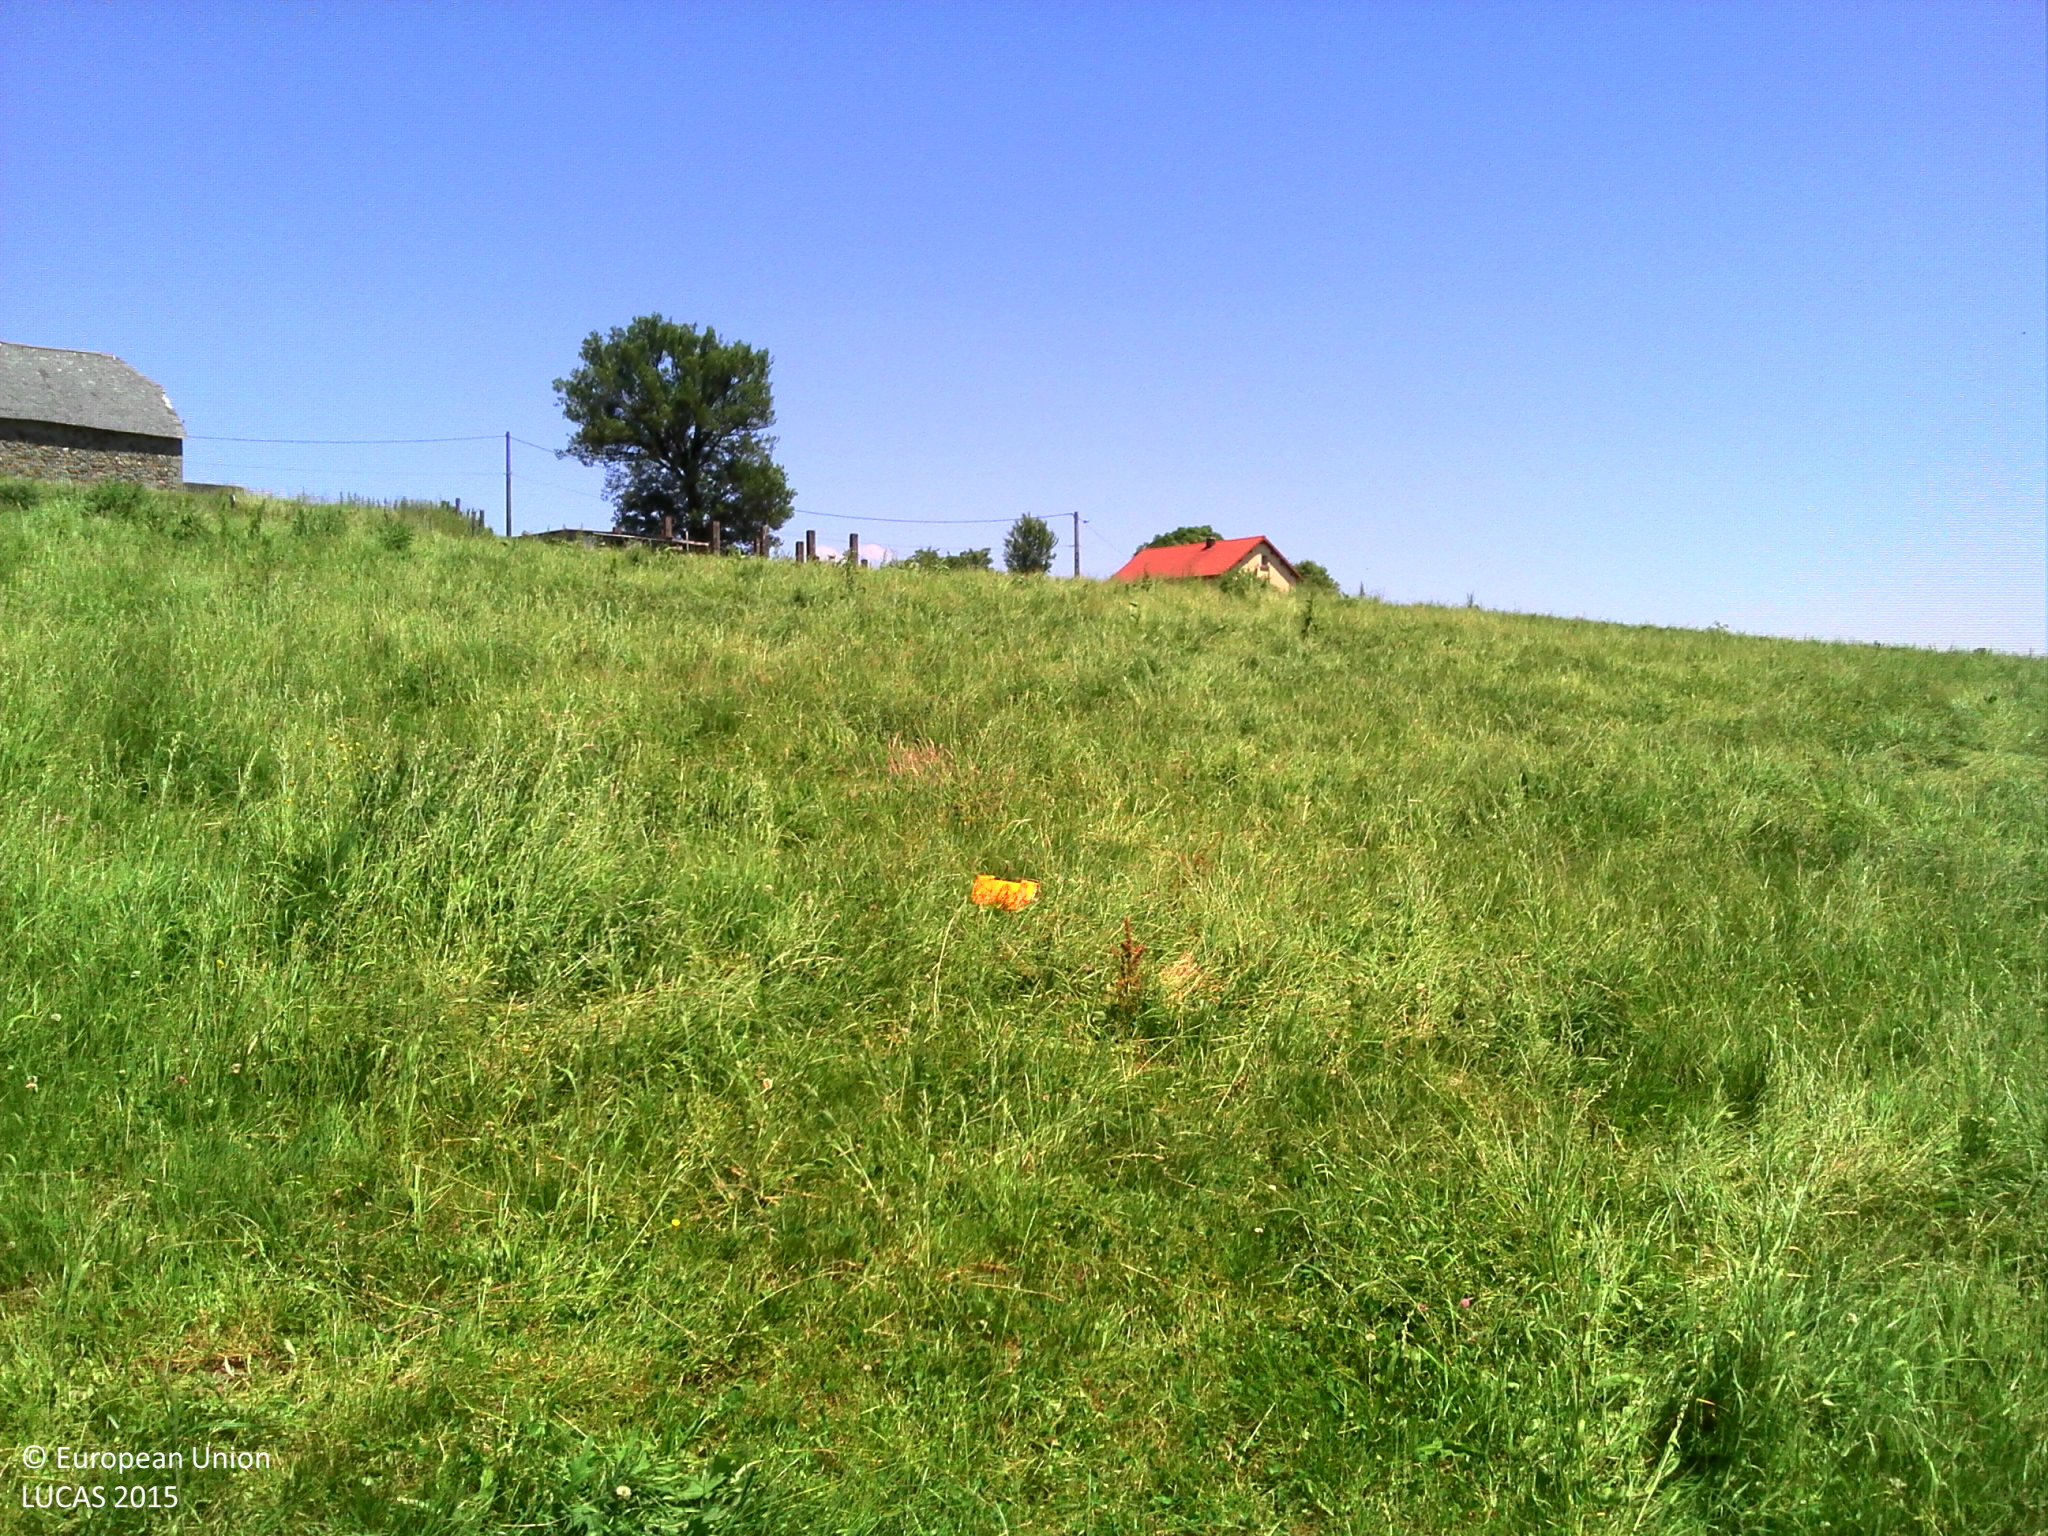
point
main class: Grassland
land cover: Grassland without tree/shrub cover
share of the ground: > 75 %
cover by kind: herbaceous plants 100 %
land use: Agriculture (excluding fallow land and kitchen gardens)
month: June
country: FR
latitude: 45.3590
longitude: 2.4286
